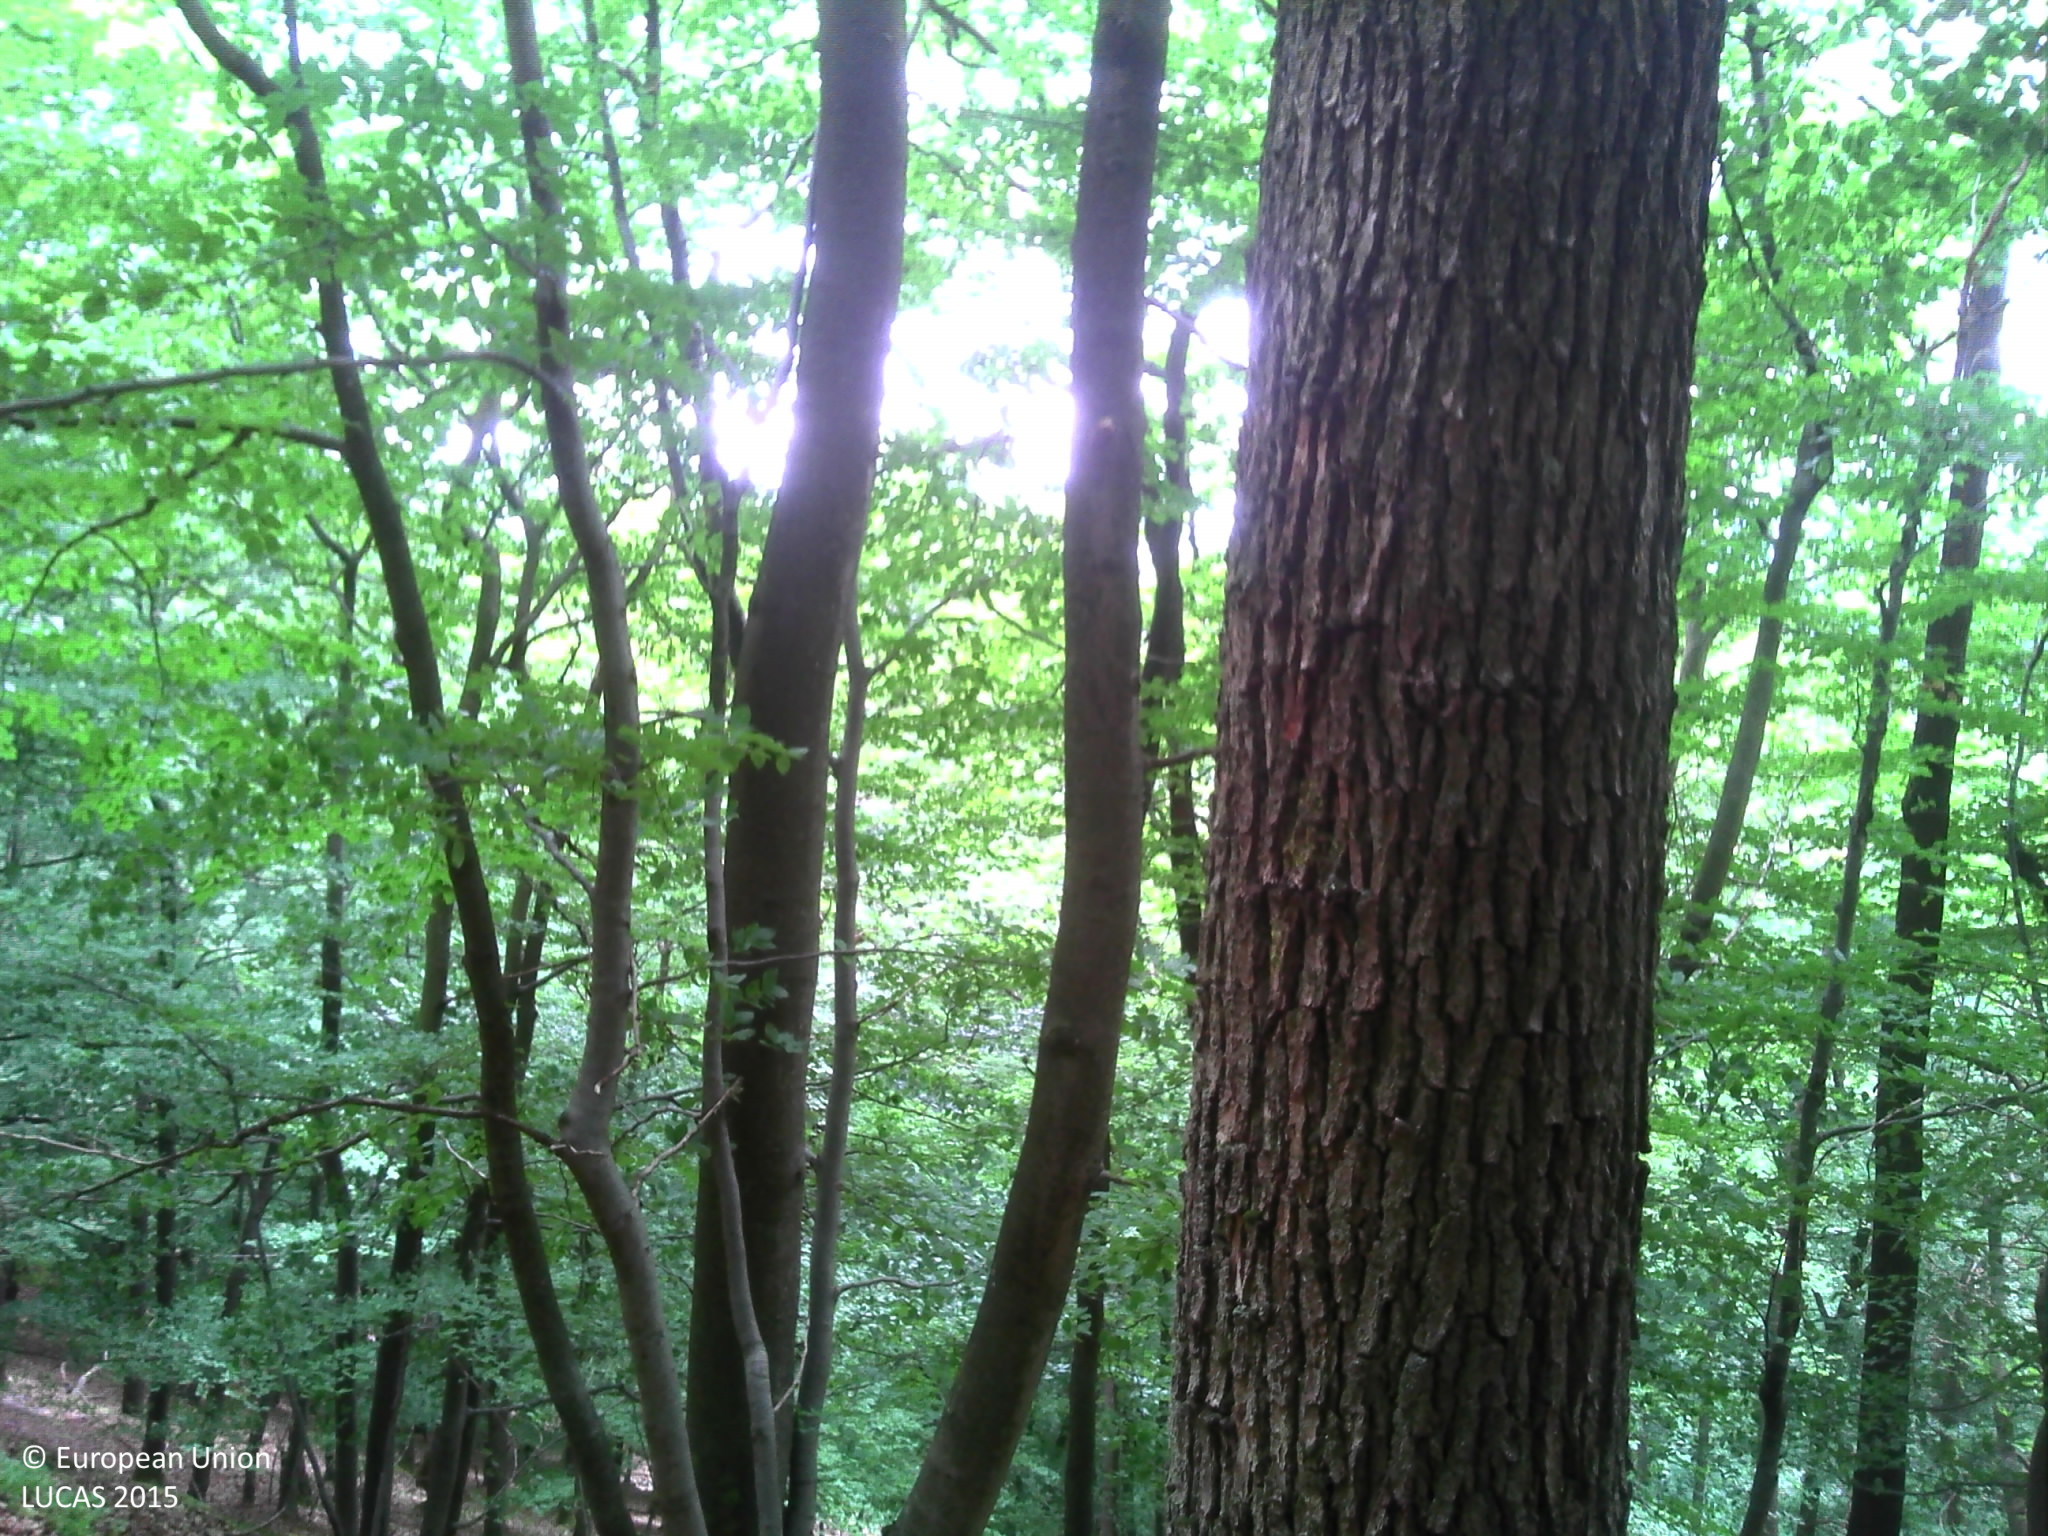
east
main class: Woodland
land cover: Broadleaved woodland
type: beech forest
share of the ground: > 75 %
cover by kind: broadleaved forest trees 100 %
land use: Forestry
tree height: > 5 m
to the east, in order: Broadleaved woodland; Tracks; Broadleaved woodland; Tracks; Broadleaved woodland
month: July
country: FR
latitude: 48.9537
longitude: 7.6108
